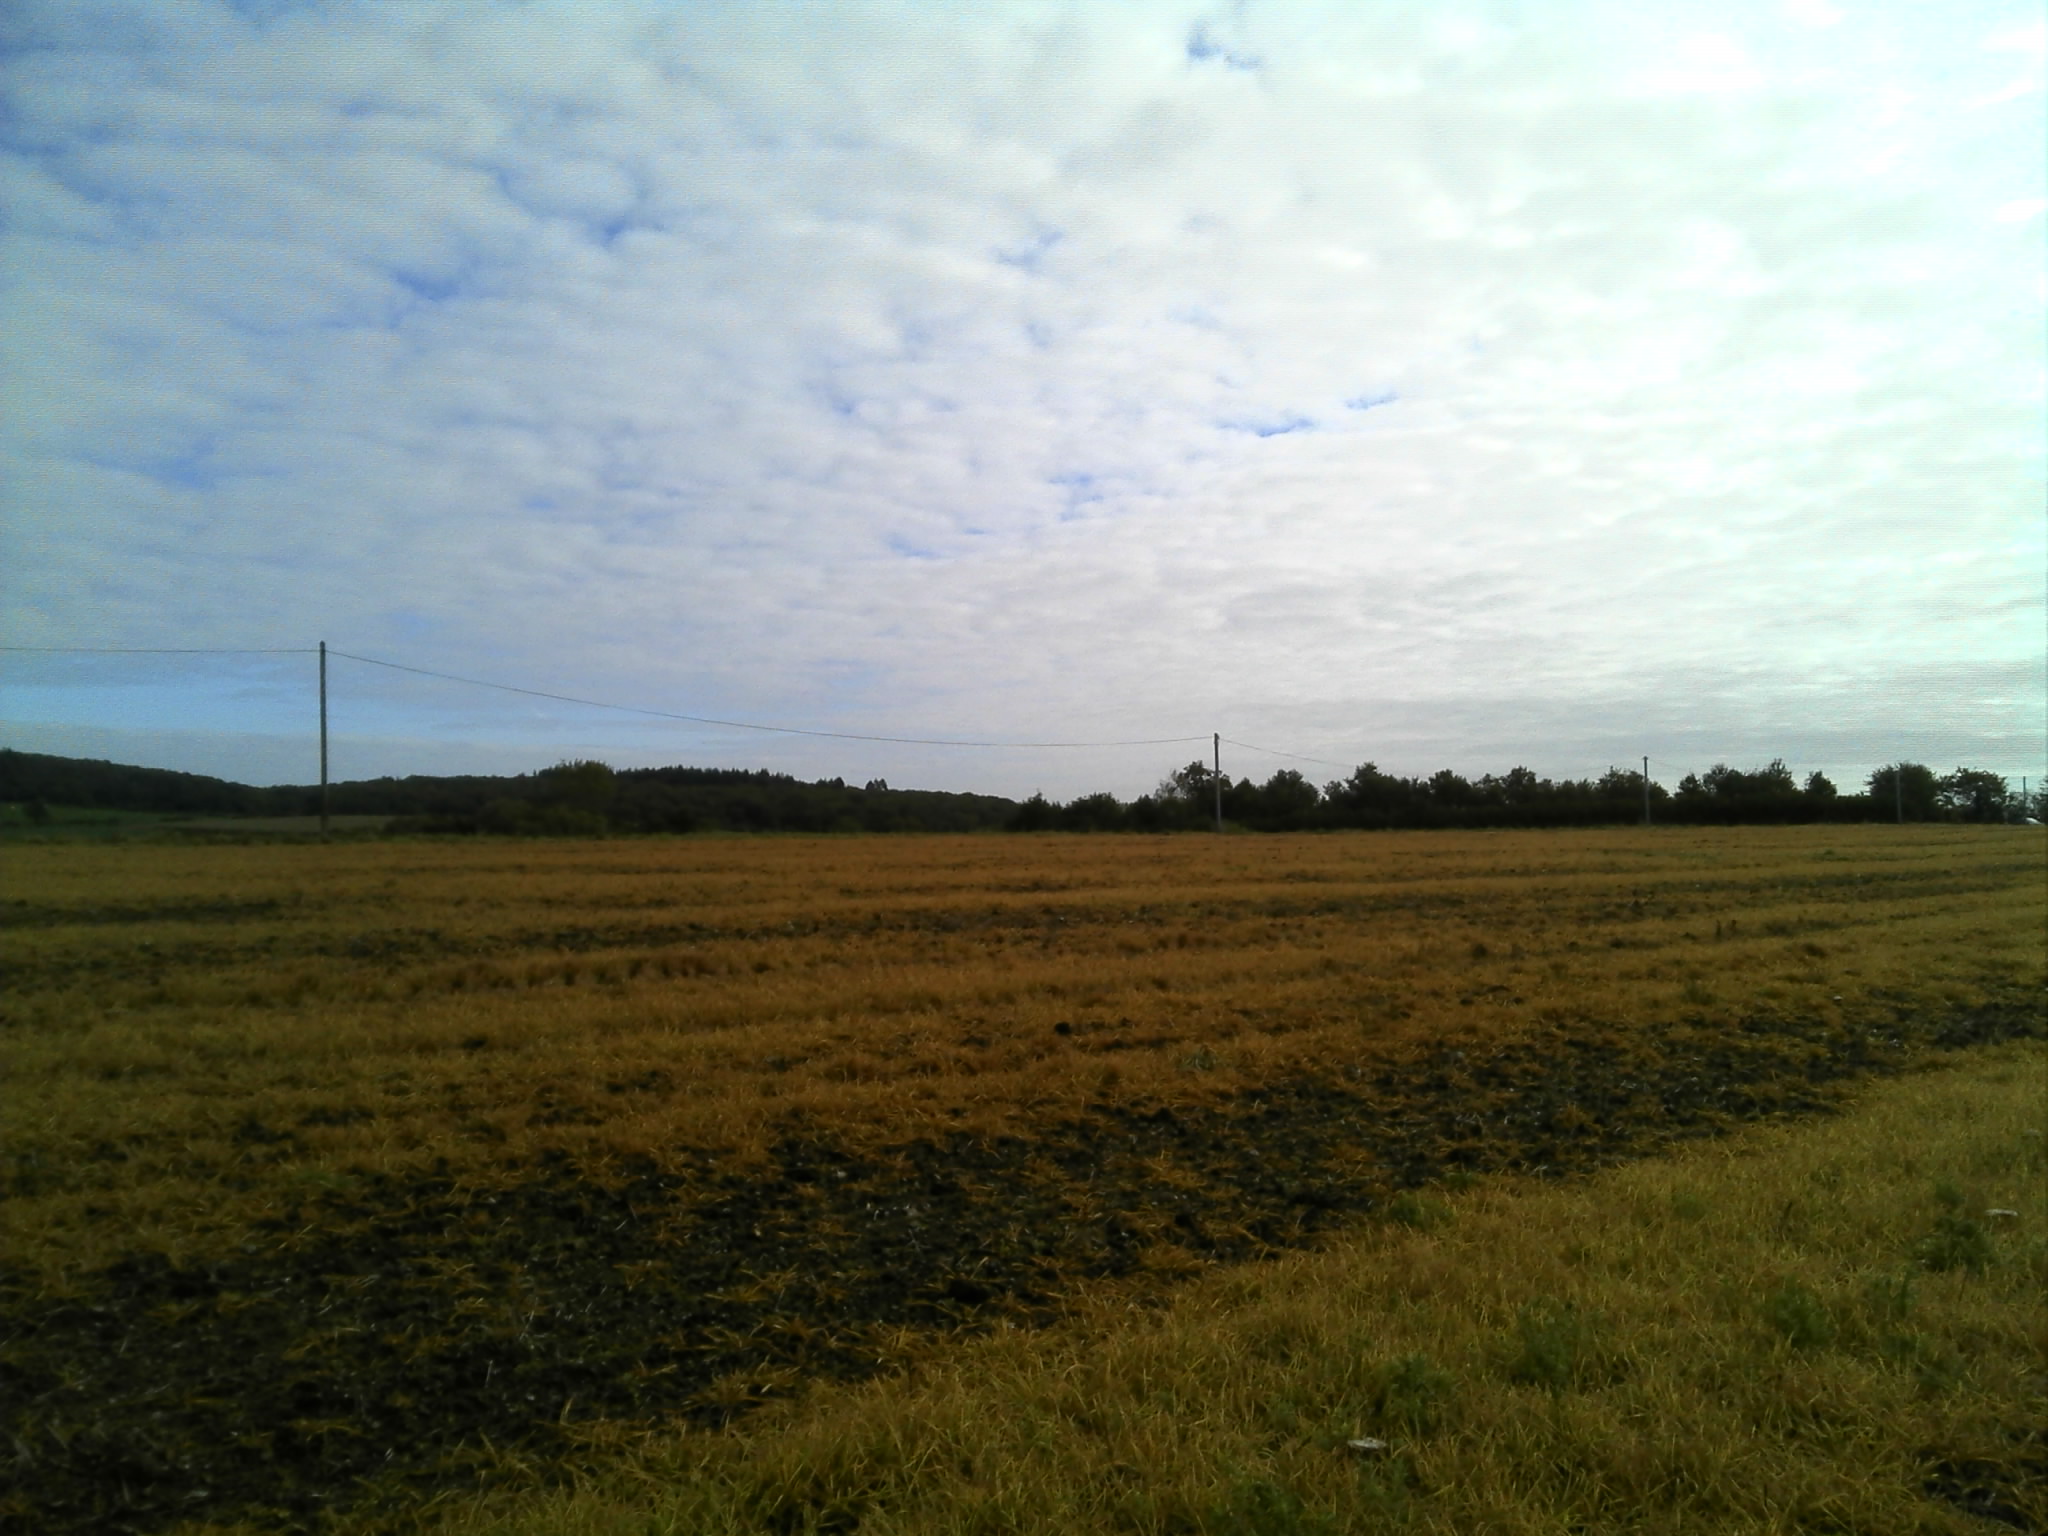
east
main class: Cropland
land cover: Common wheat
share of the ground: > 75 %
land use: Agriculture (excluding fallow land and kitchen gardens)
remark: Harvested field
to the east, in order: Common wheat; Electric lines; Ditches and canals; Grass margins; Paved roads, cycling and walking lanes; Grass margins; Rape and turnip rape; Abandoned hedges; Tracks; Broadleaved woodland; Paved roads, cycling and walking lanes; Electric lines; Broadleaved woodland; Rape and turnip rape
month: October
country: FR
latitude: 47.7576
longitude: -1.0442
